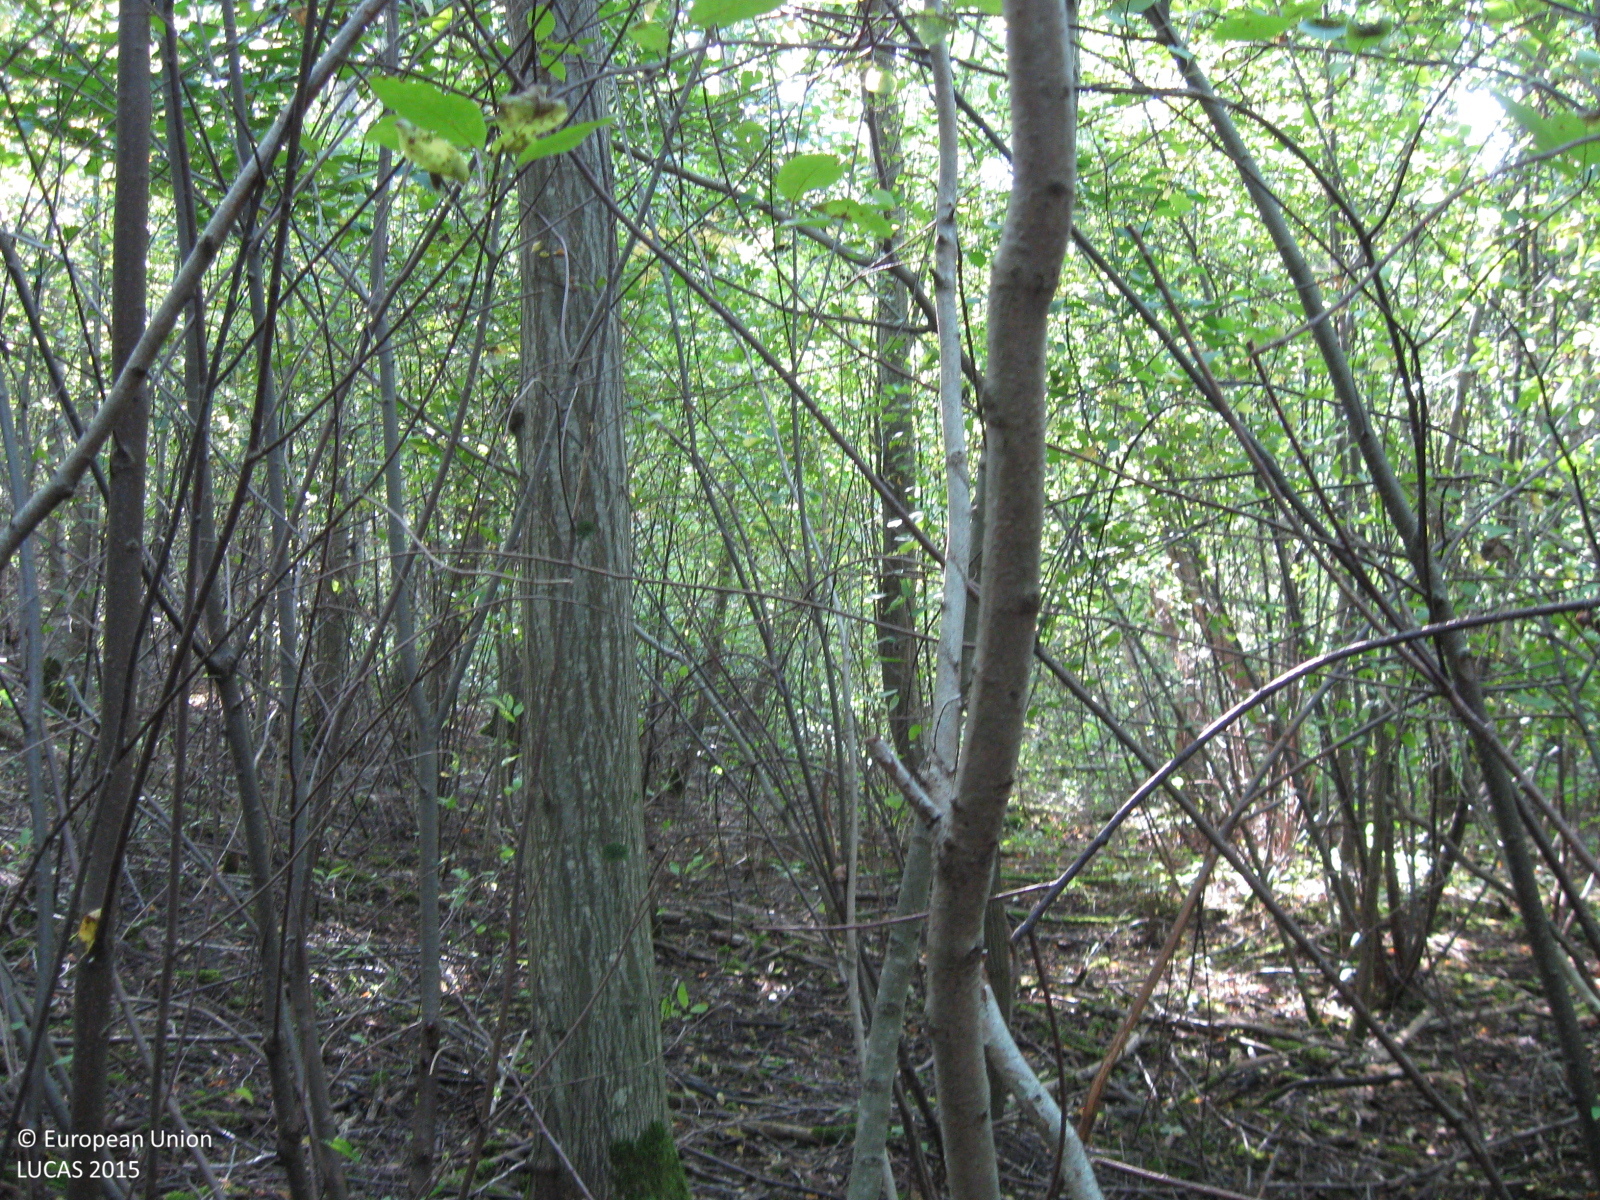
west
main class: Woodland
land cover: Broadleaved woodland
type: non-riverine alder, birch or aspen forest
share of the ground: > 75 %
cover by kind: broadleaved forest trees 95 %, unconsolidated bare surface 5 %
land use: Forestry
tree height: > 5 m
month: August
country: LT
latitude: 55.4636
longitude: 23.2169
